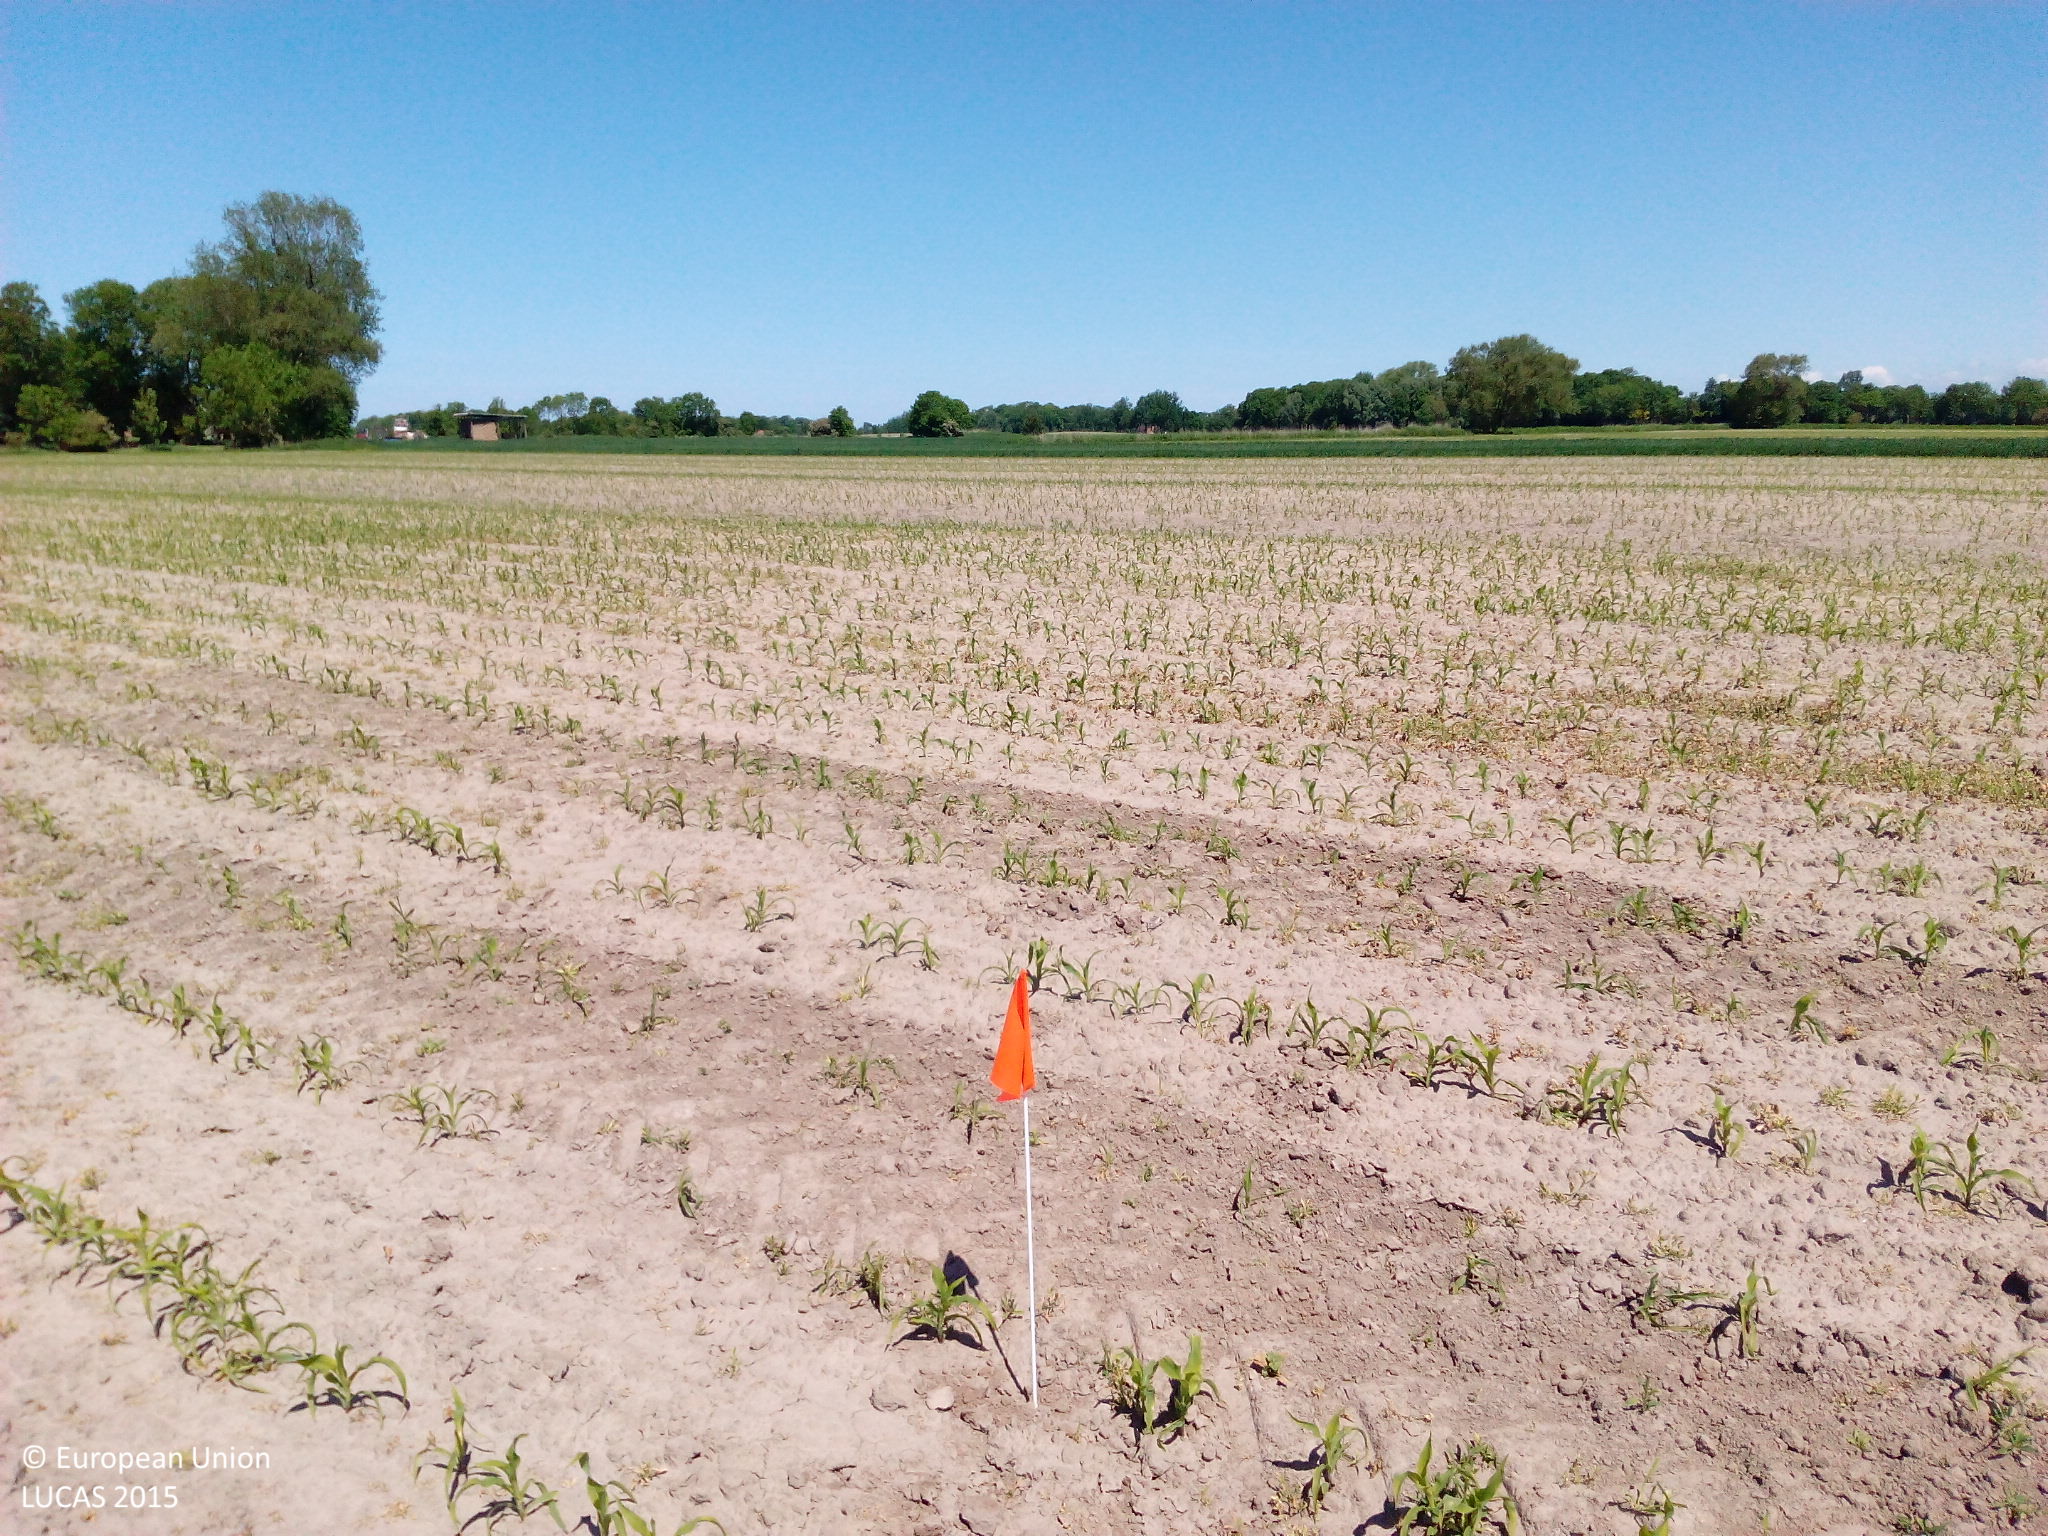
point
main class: Cropland
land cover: Maize
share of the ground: < 10 %
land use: Agriculture (excluding fallow land and kitchen gardens)
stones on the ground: < 10 %
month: June
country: DE
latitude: 53.6803
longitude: 8.5018
